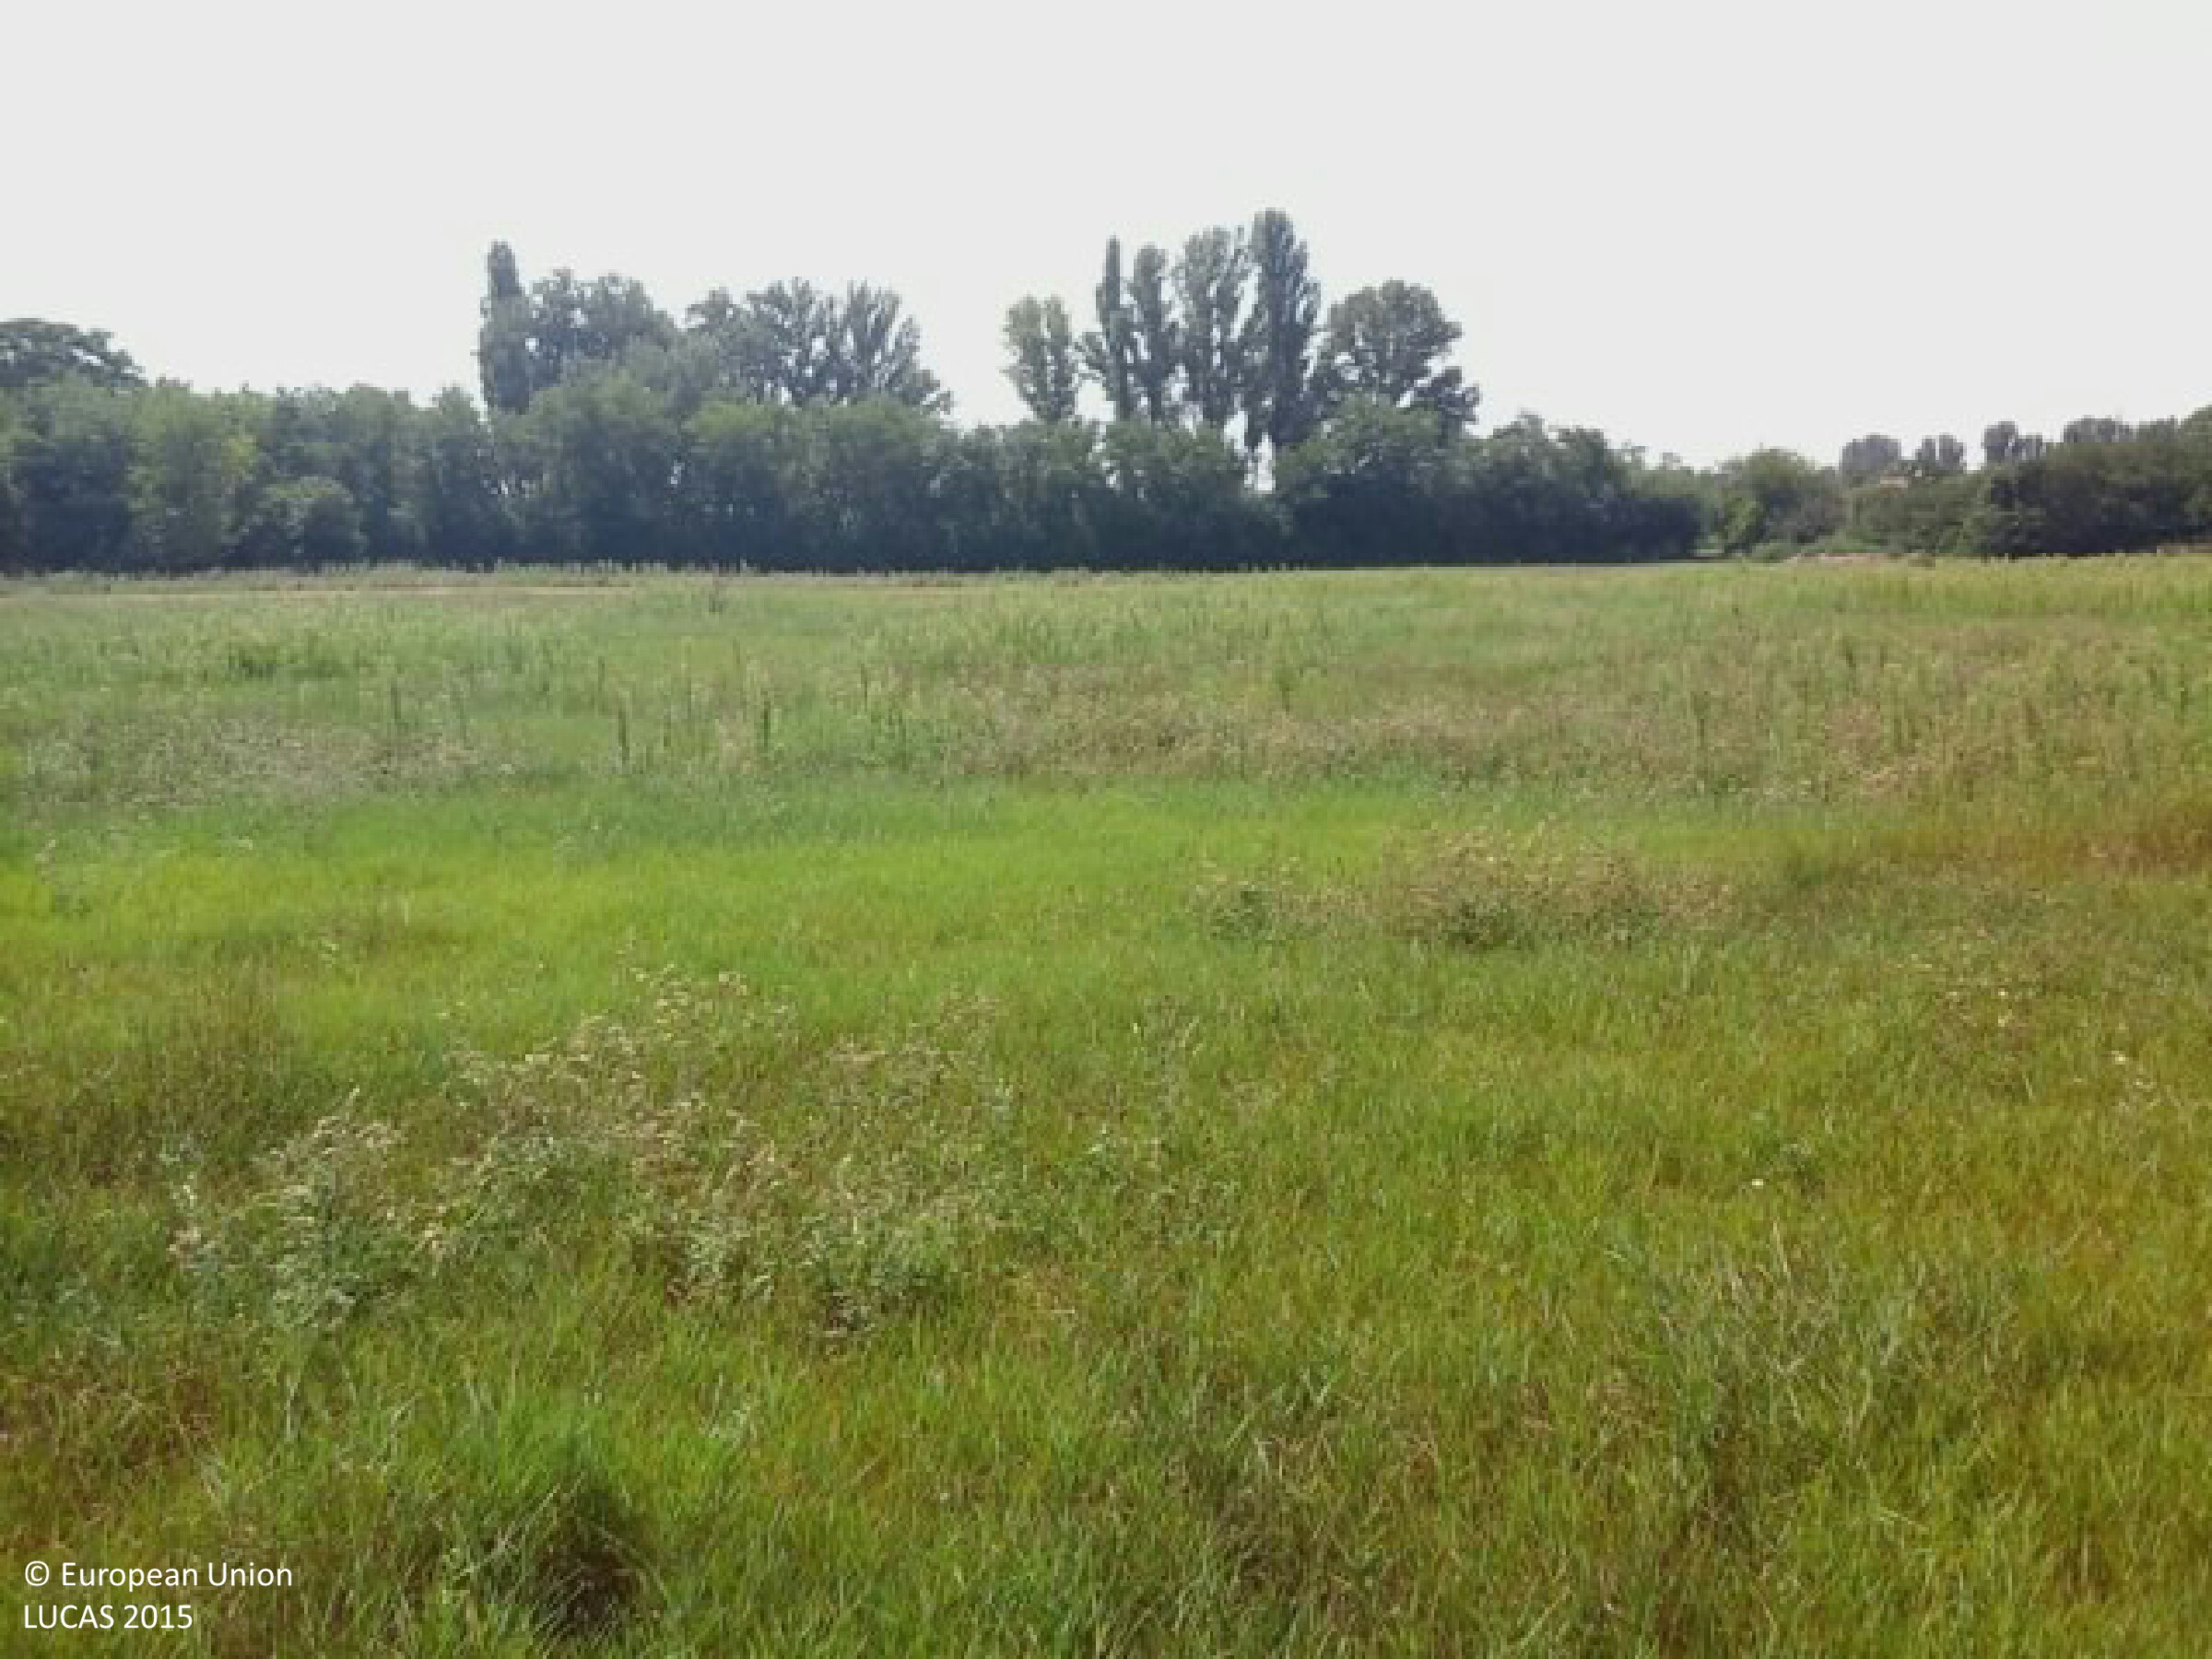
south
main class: Grassland
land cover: Grassland without tree/shrub cover
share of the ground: > 75 %
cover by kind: herbaceous plants 100 %
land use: Agriculture (excluding fallow land and kitchen gardens)
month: August
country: HU
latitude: 47.0753
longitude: 19.0108
